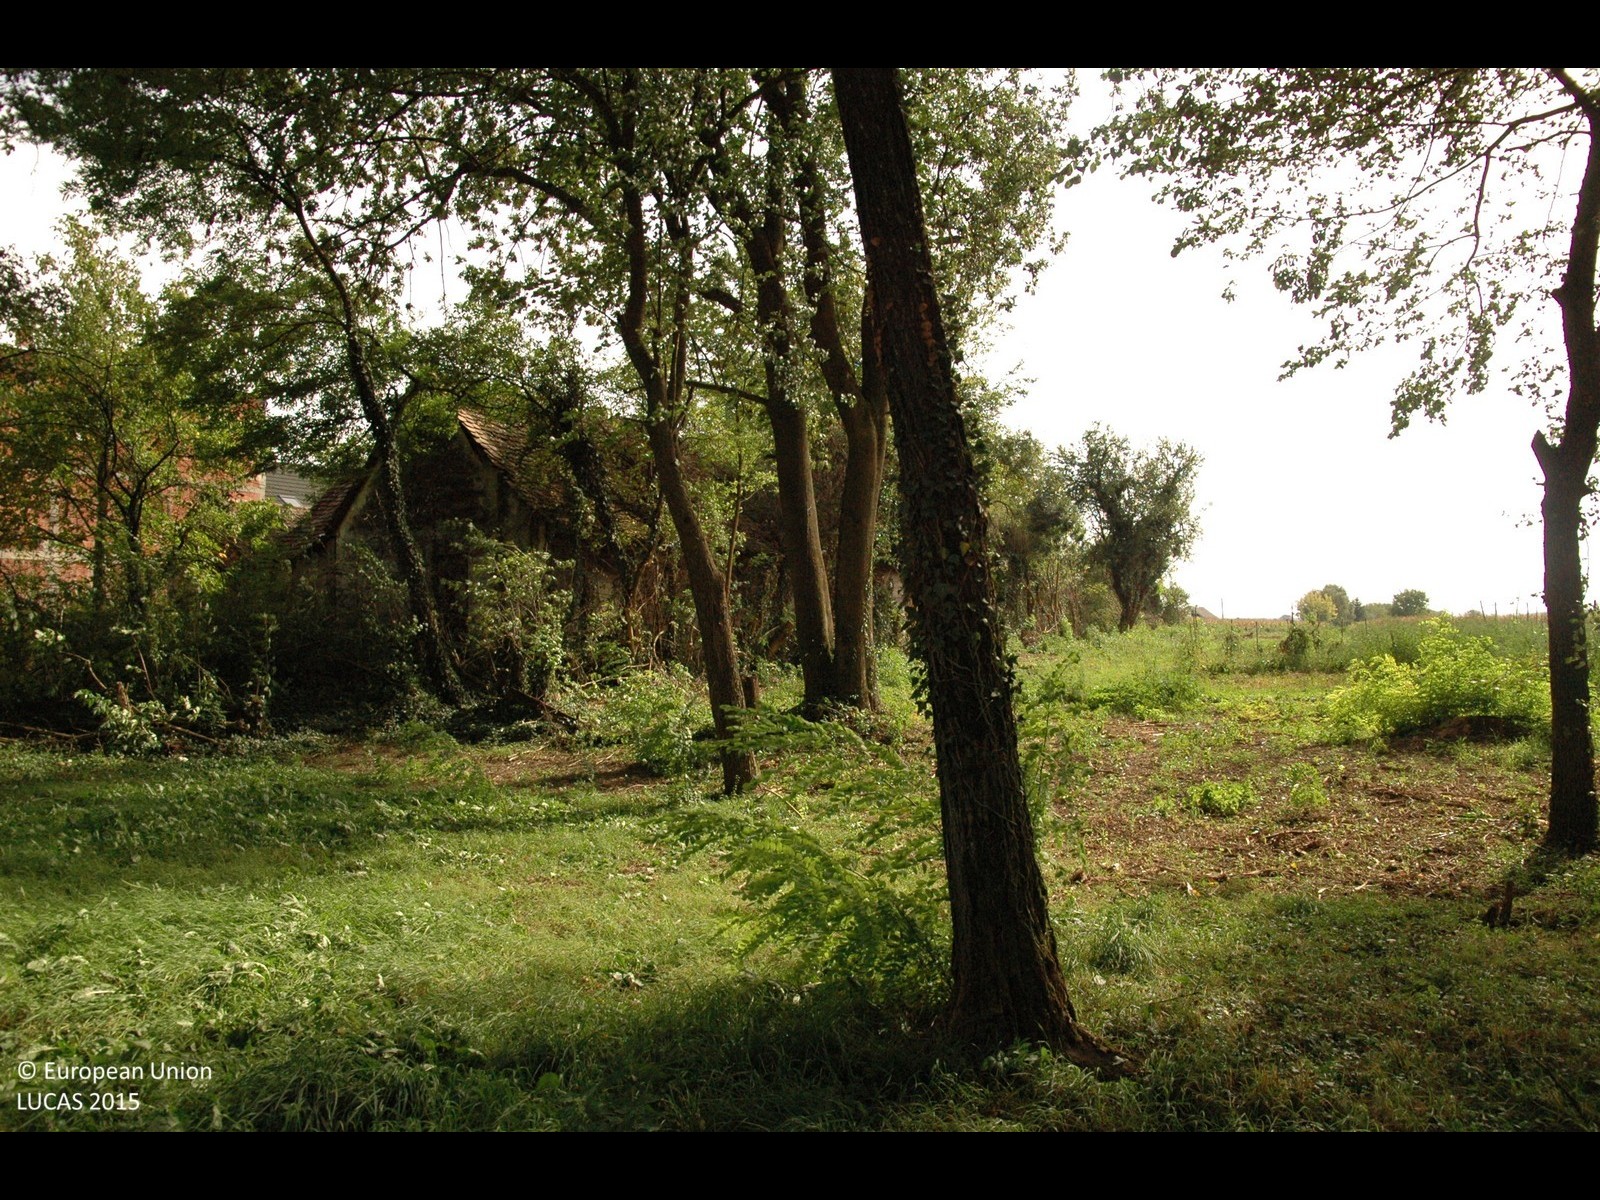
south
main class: Woodland
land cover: Broadleaved woodland
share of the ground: > 75 %
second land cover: Grassland without tree/shrub cover
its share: > 75 %
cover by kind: broadleaved forest trees 80 %, herbaceous plants 20 %
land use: Amenities, museums, leisure
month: September
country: HR
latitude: 45.7327
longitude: 15.9732
